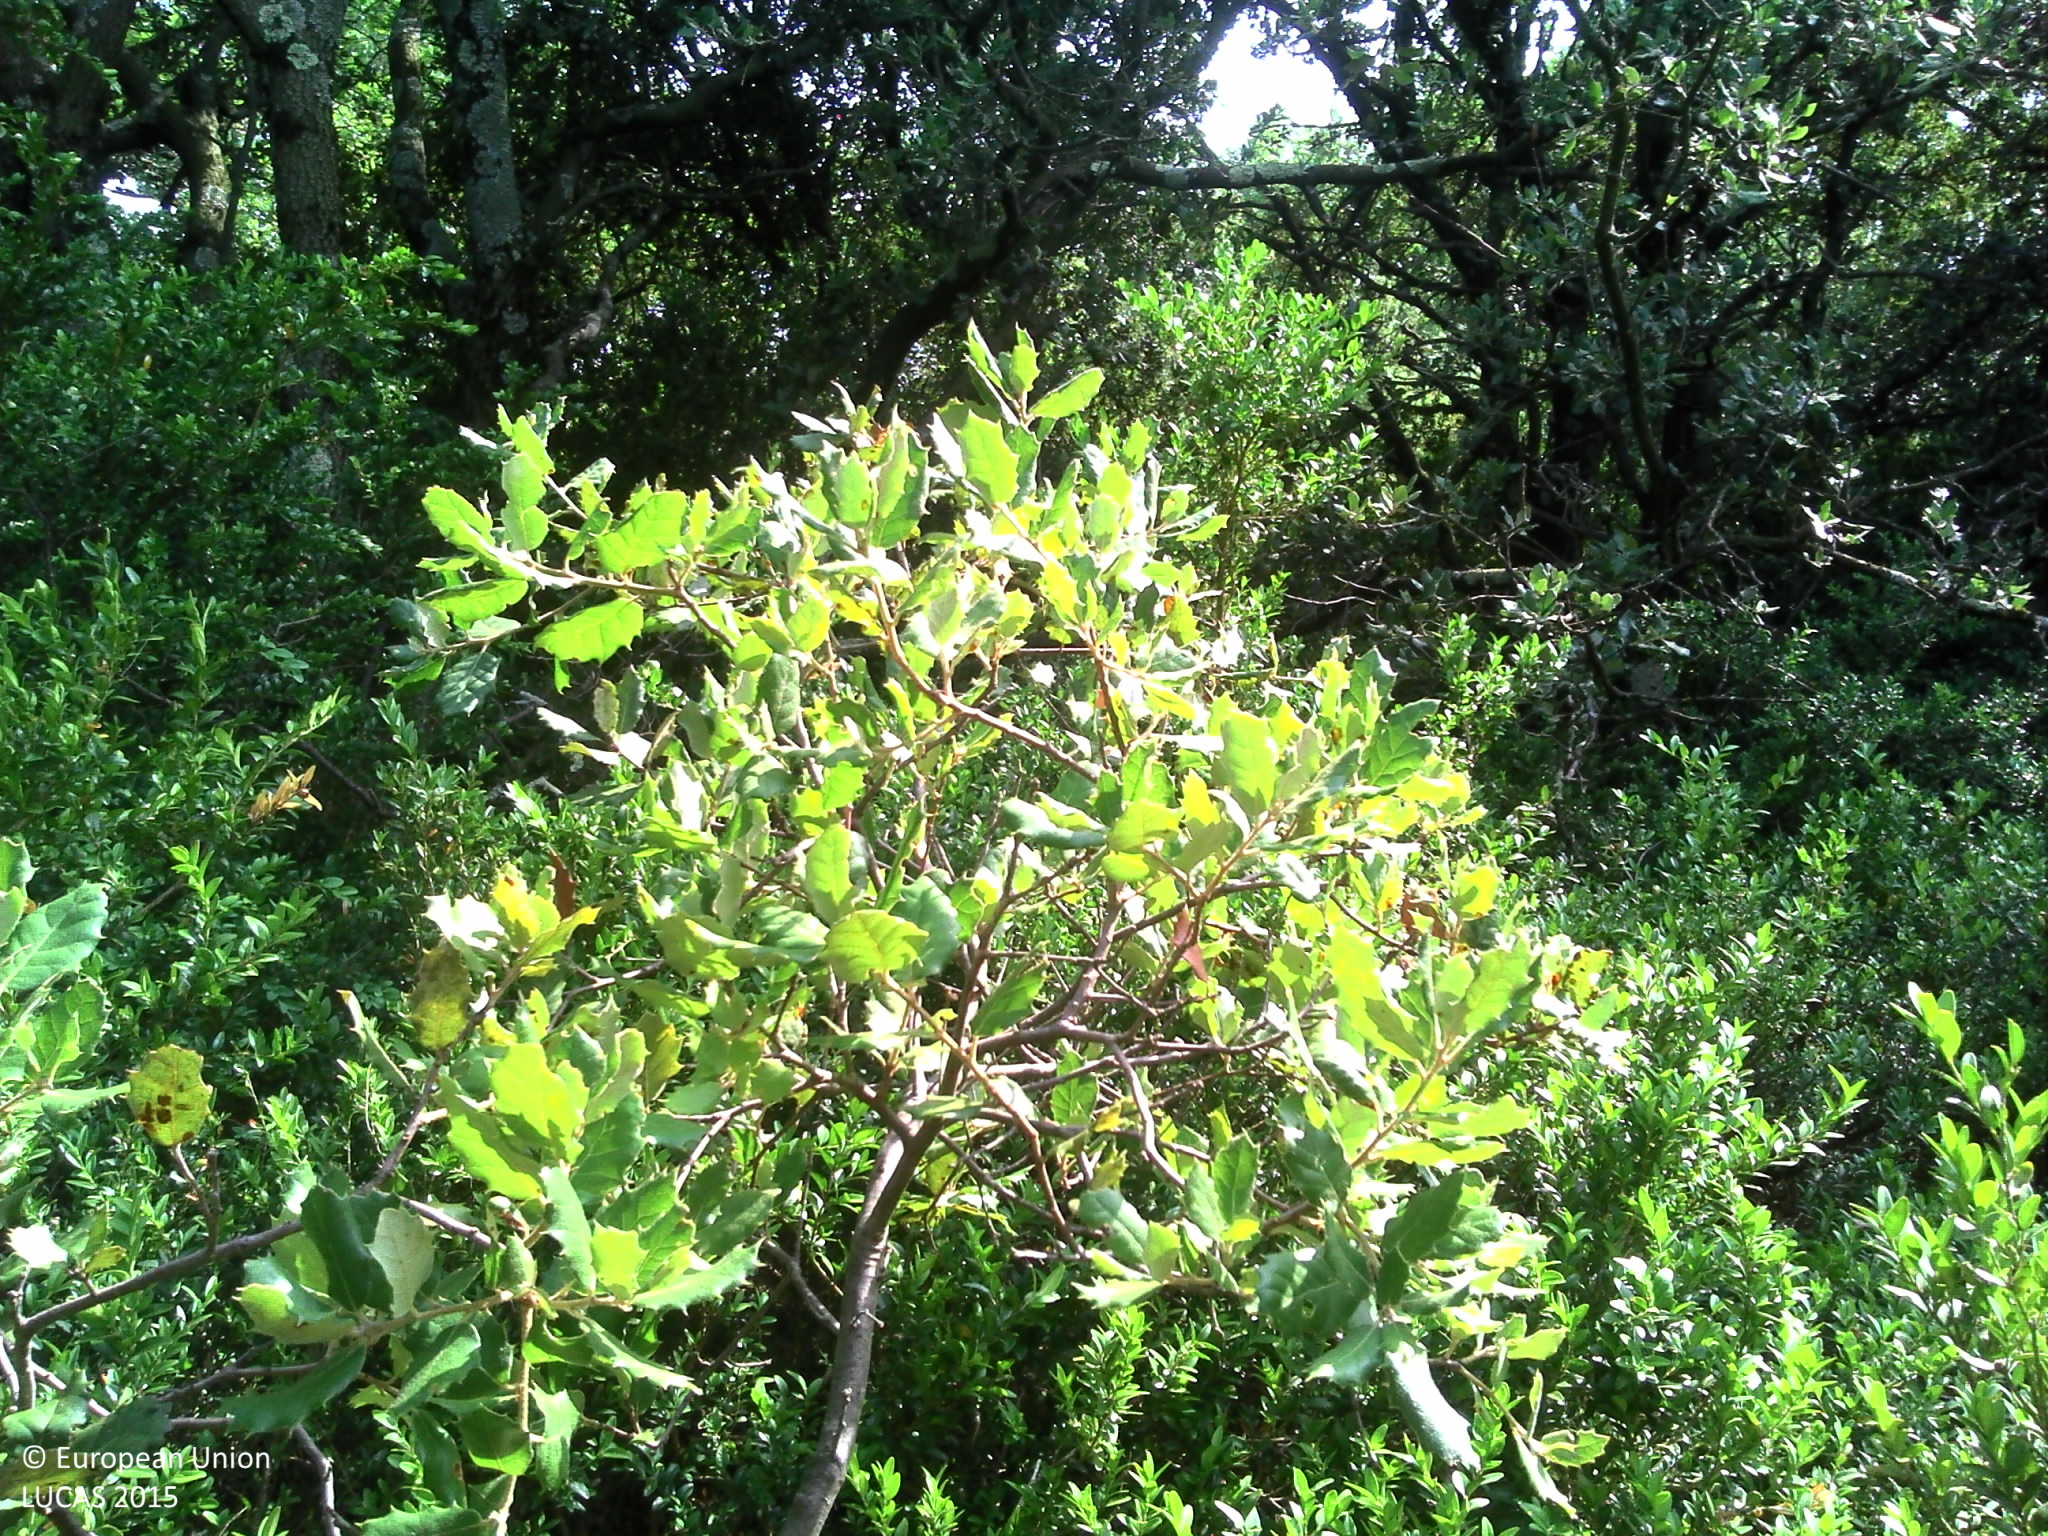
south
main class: Woodland
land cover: Broadleaved woodland
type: thermophilous deciduous forest
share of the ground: > 75 %
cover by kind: broadleaved forest trees 100 %
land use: Forestry
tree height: < 5 m
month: July
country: FR
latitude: 44.4355
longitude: 4.7682
